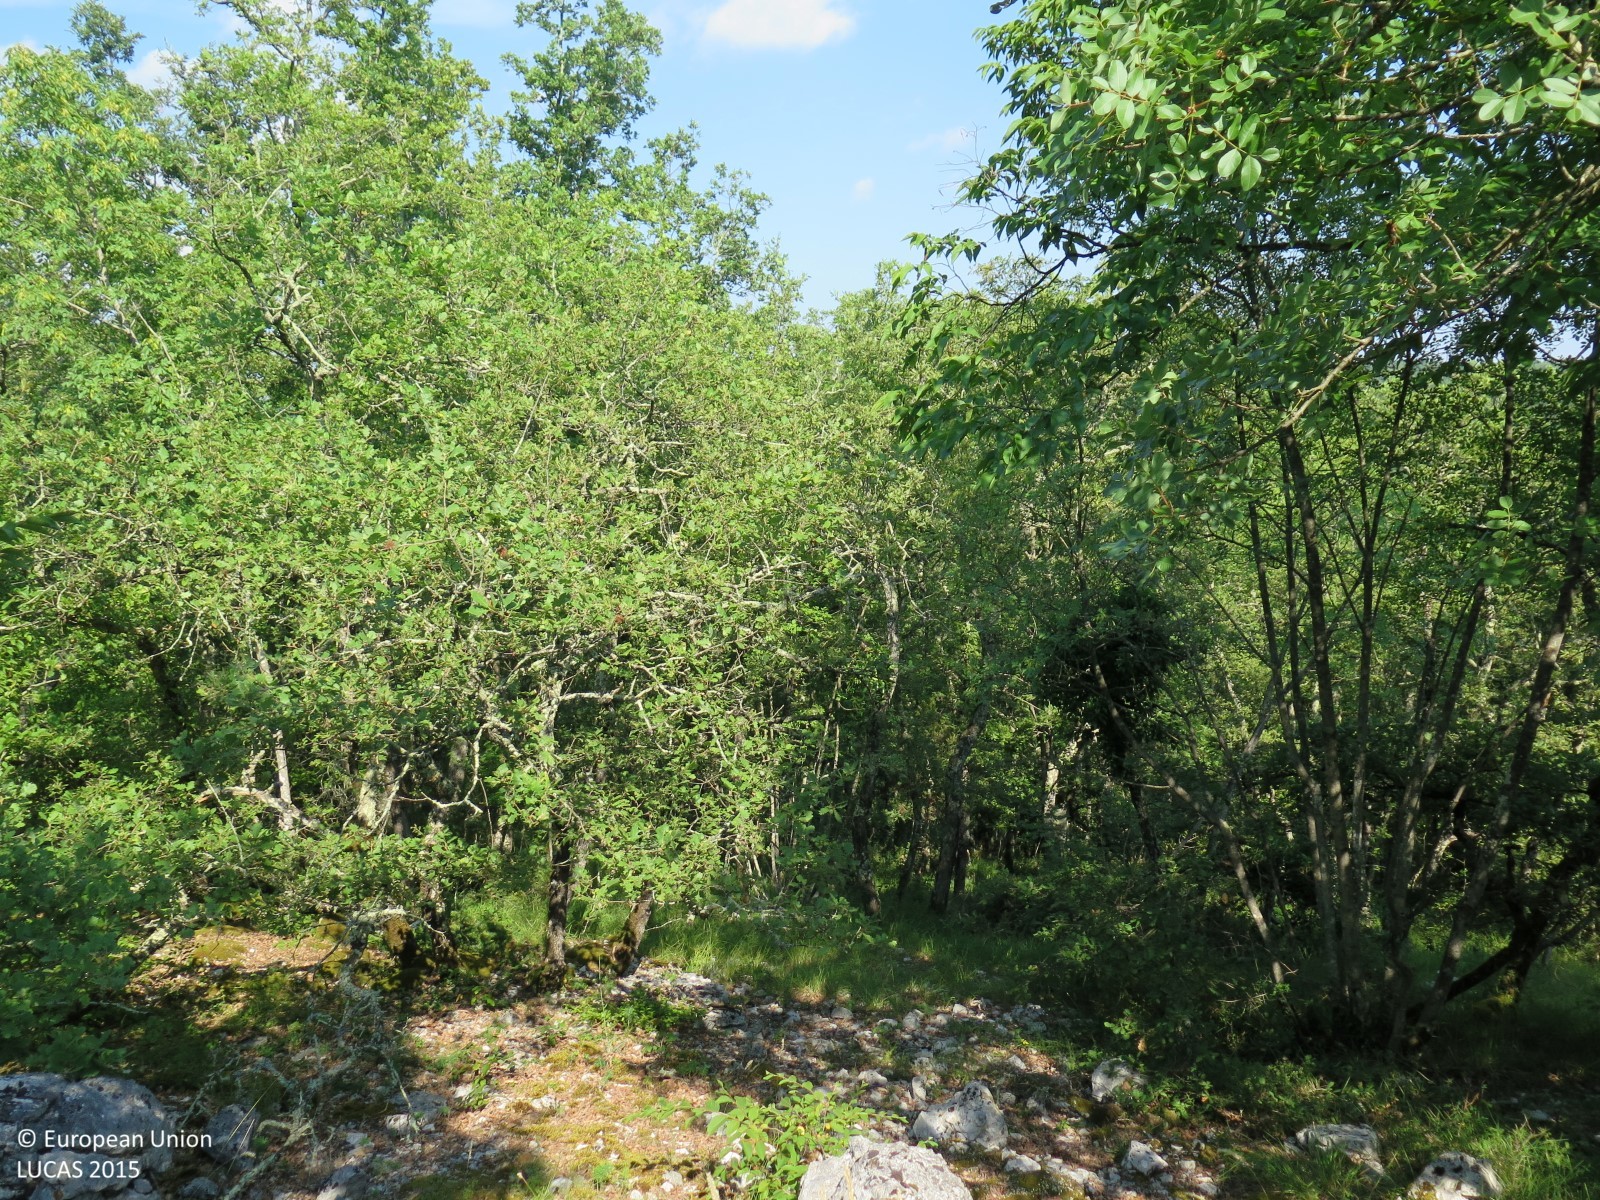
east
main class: Woodland
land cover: Broadleaved woodland
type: mesophytic deciduous forest
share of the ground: > 75 %
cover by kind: broadleaved forest trees 90 %, herbaceous plants 5 %, unconsolidated bare surface 5 %
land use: Semi-natural and natural areas not in use
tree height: > 5 m
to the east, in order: Broadleaved woodland; Rocks and stones; Broadleaved woodland; Rocks and stones; Broadleaved woodland; Tracks; Shrubland without tree cover; Grassland with sparse tree/shrub cover
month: July
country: HR
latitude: 45.2356
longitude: 13.8545
